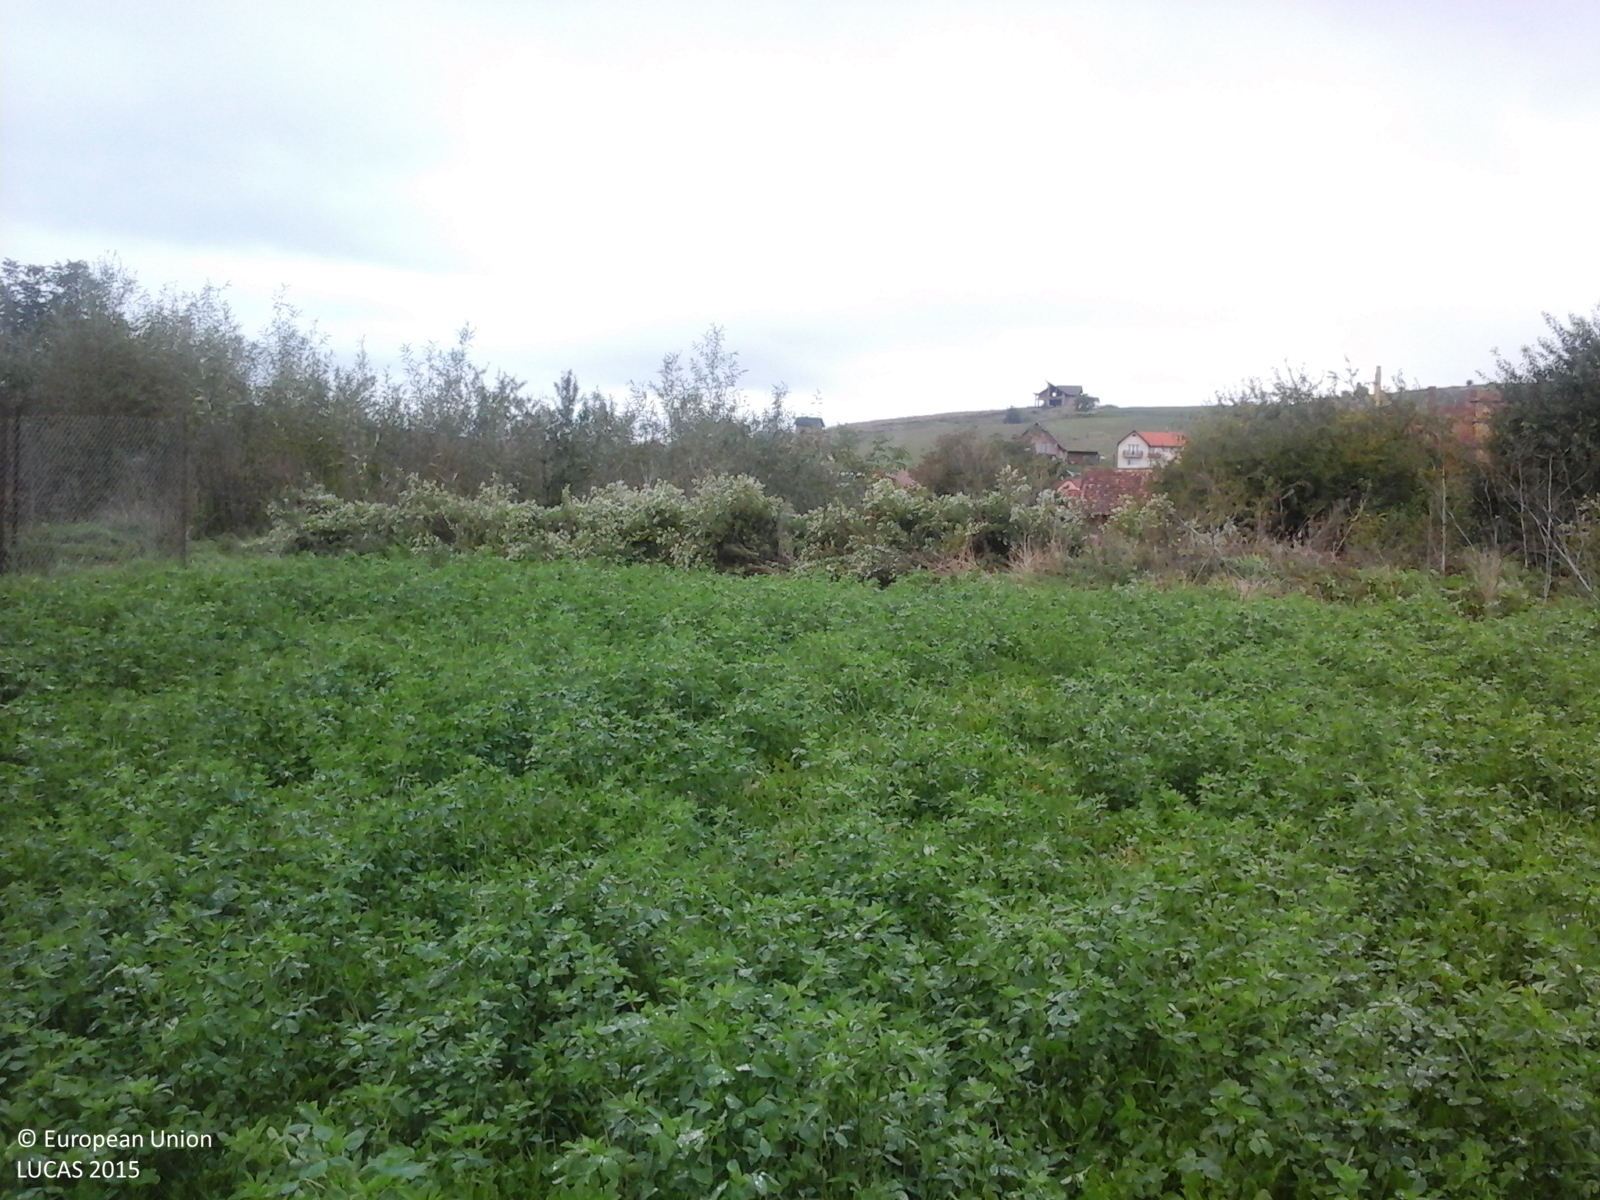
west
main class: Cropland
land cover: Lucerne
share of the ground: > 75 %
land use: Agriculture (excluding fallow land and kitchen gardens)
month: October
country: RO
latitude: 45.8435
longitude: 24.1489
